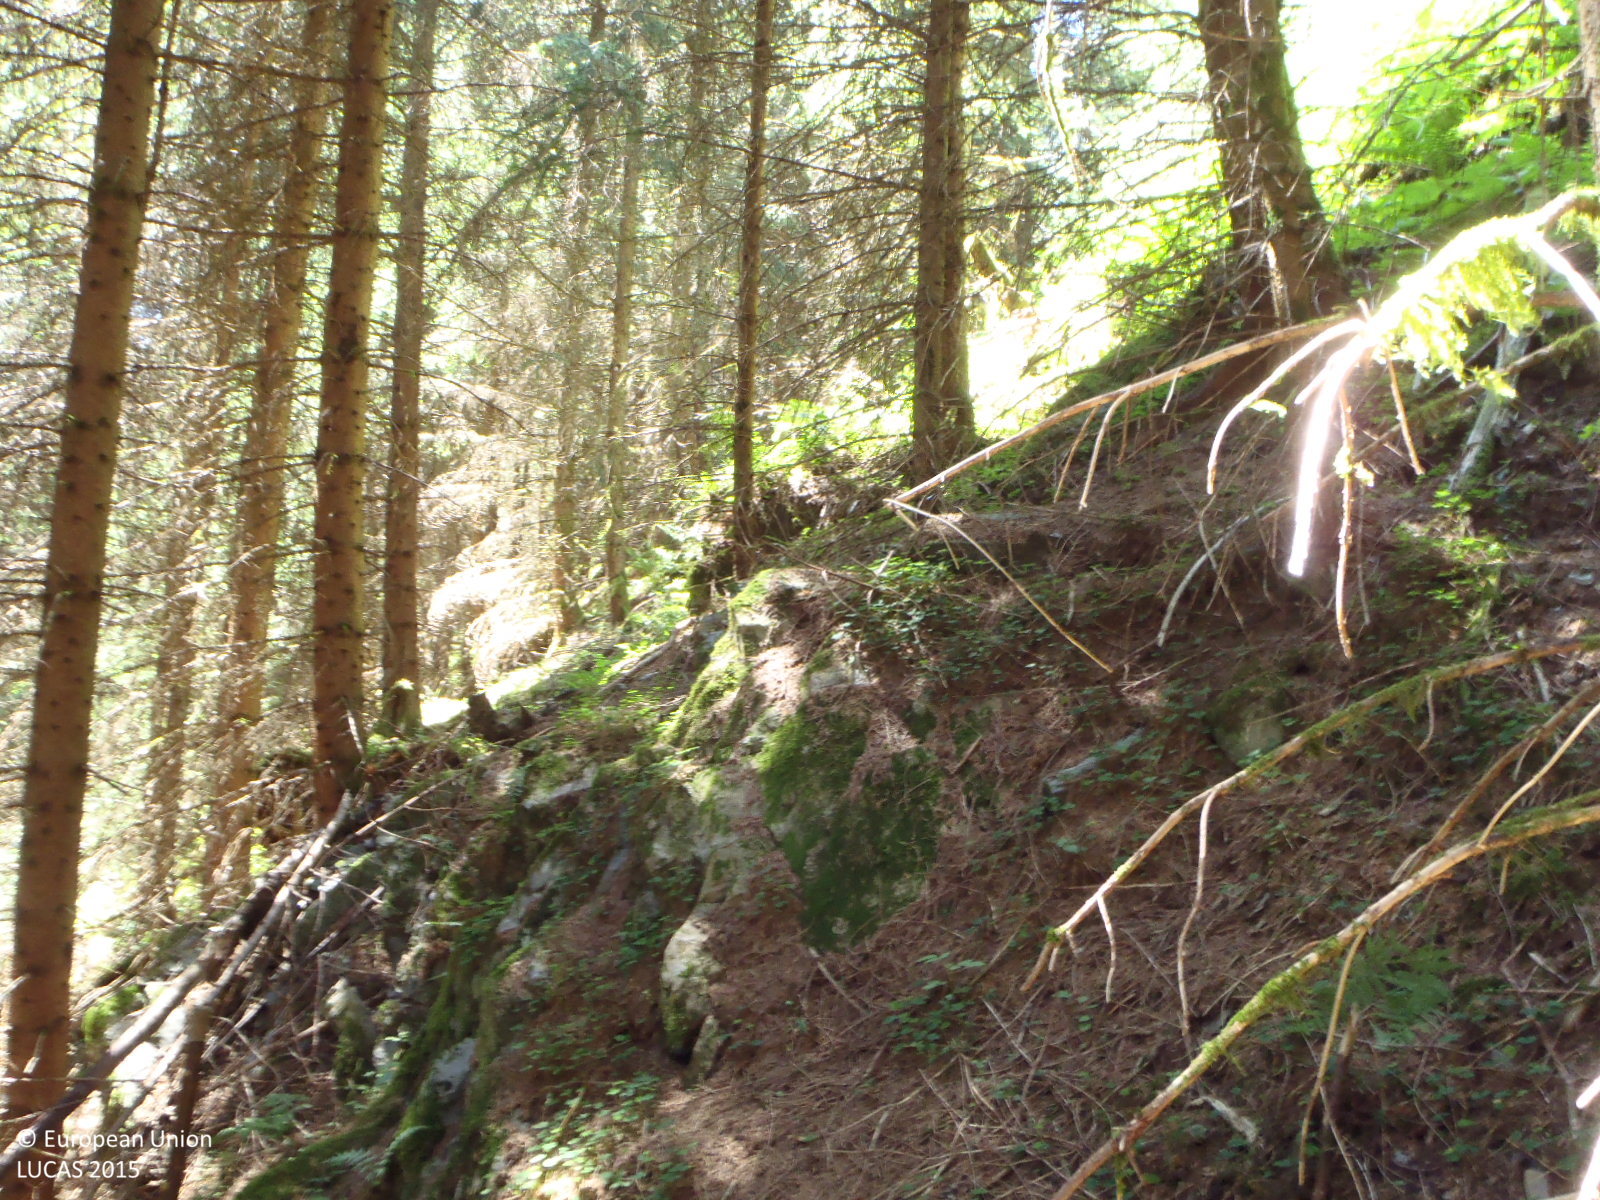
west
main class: Woodland
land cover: Spruce dominated coniferous woodland
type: alpine coniferous forest
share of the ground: > 75 %
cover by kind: coniferous forest trees 95 %, lichens and mosses 5 %
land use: Forestry
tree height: > 5 m
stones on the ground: < 10 %
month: July
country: AT
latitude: 47.3873
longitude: 12.3959
